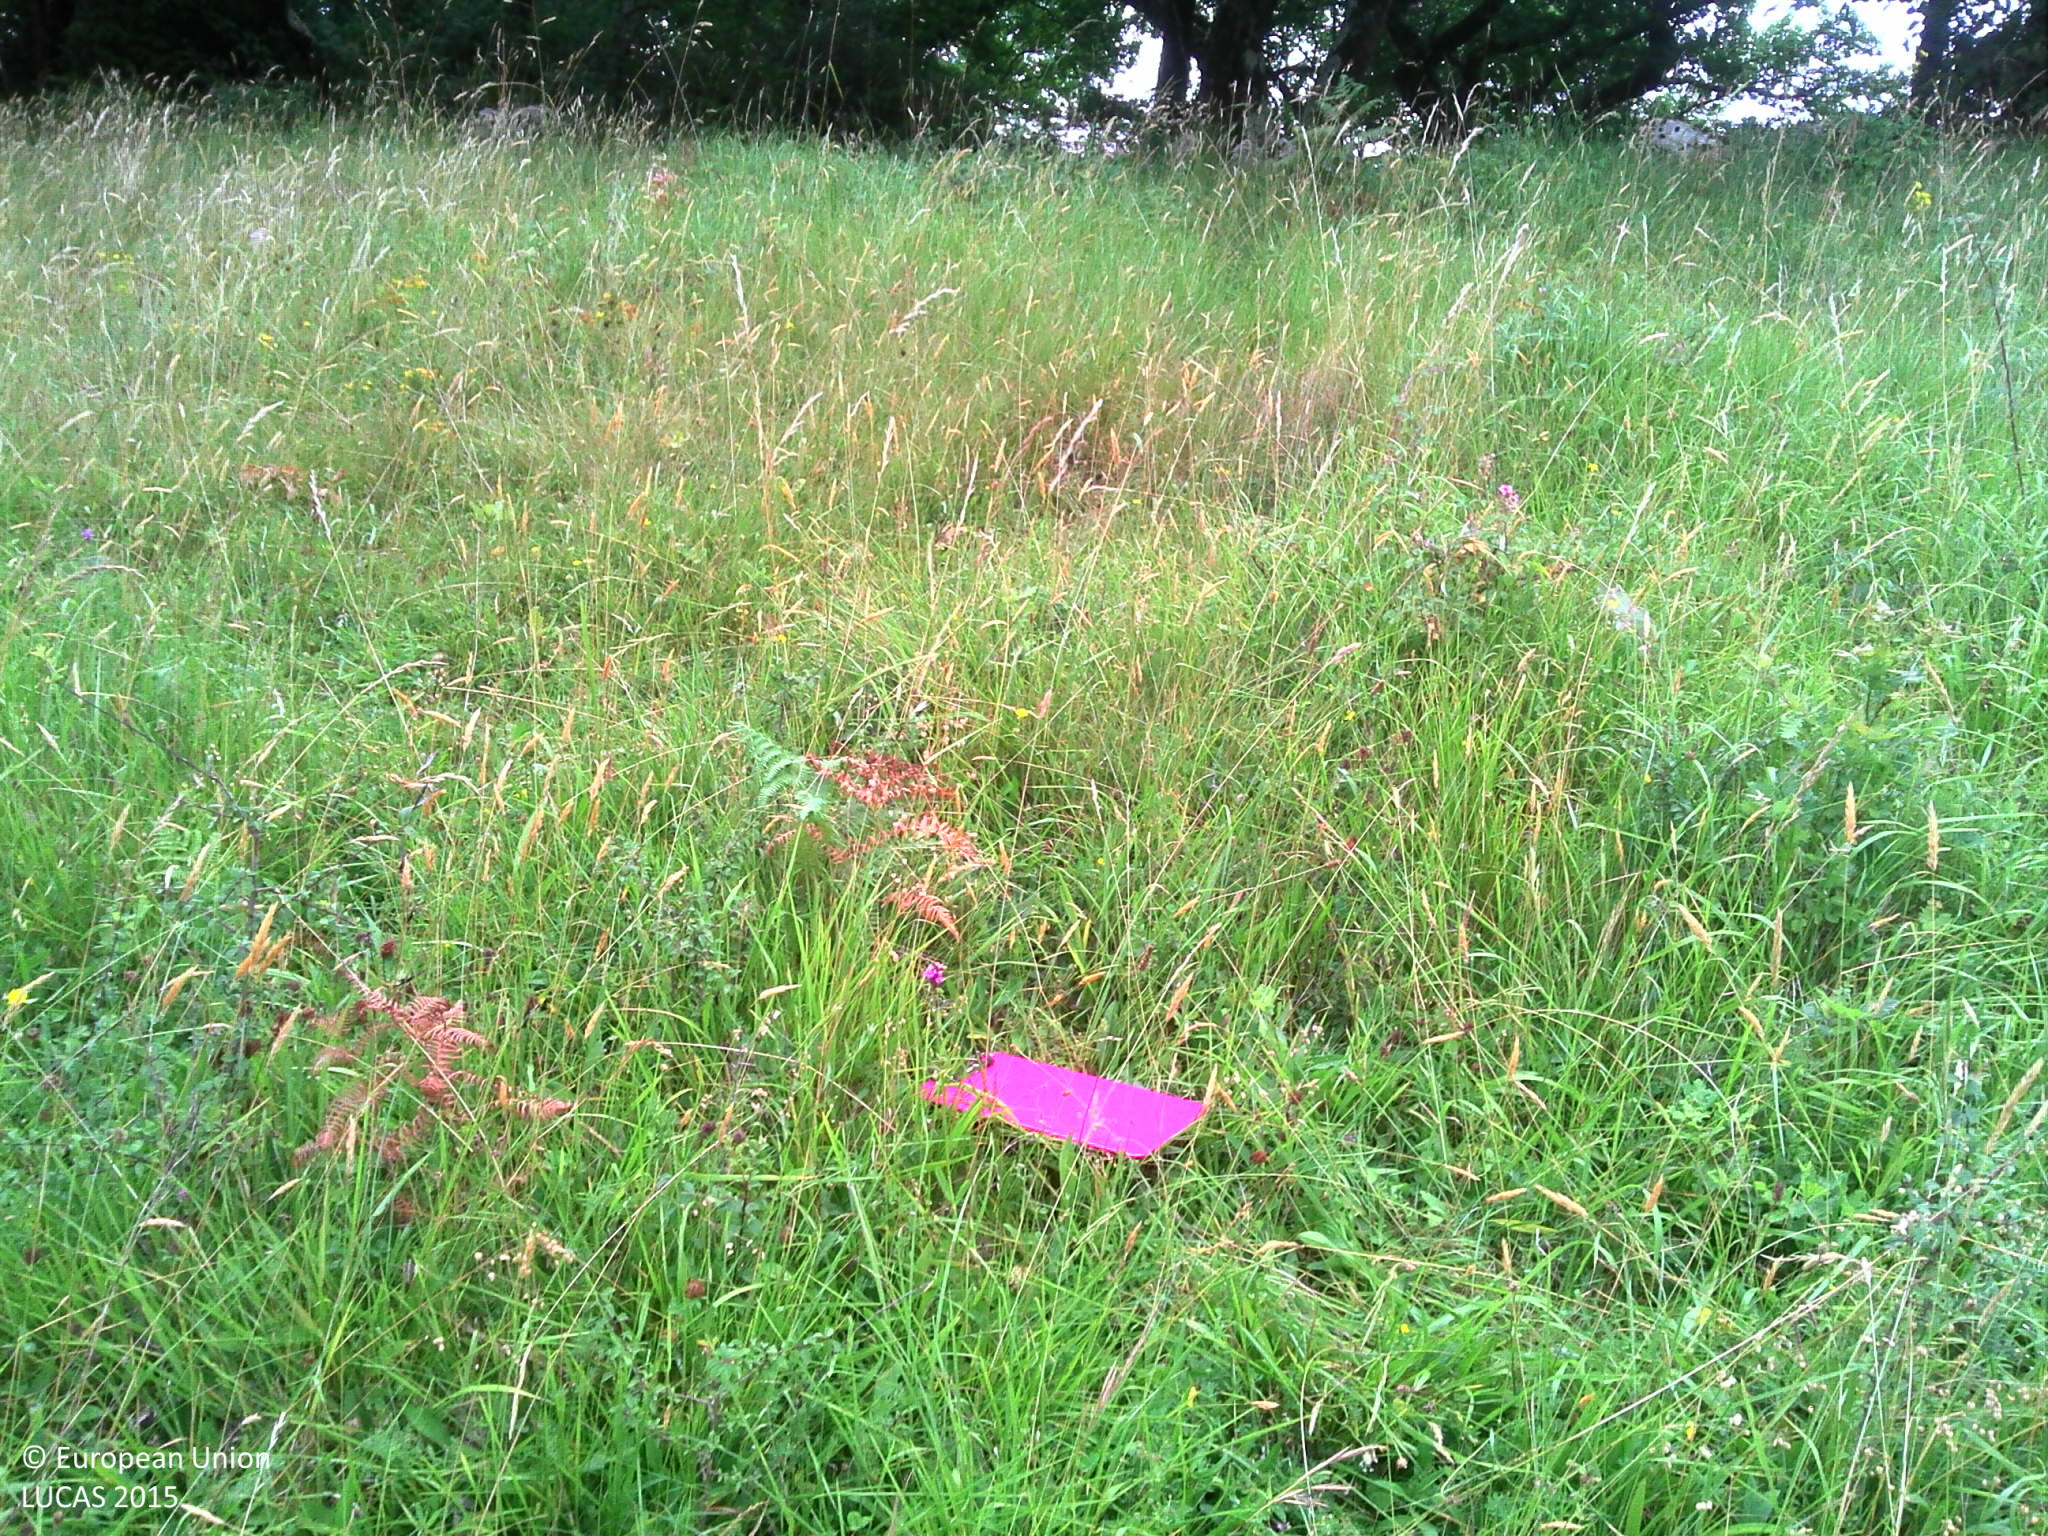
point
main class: Grassland
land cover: Grassland without tree/shrub cover
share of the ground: > 75 %
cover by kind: herbaceous plants 100 %
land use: Agriculture (excluding fallow land and kitchen gardens)
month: July
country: FR
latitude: 43.0222
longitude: 1.5022
